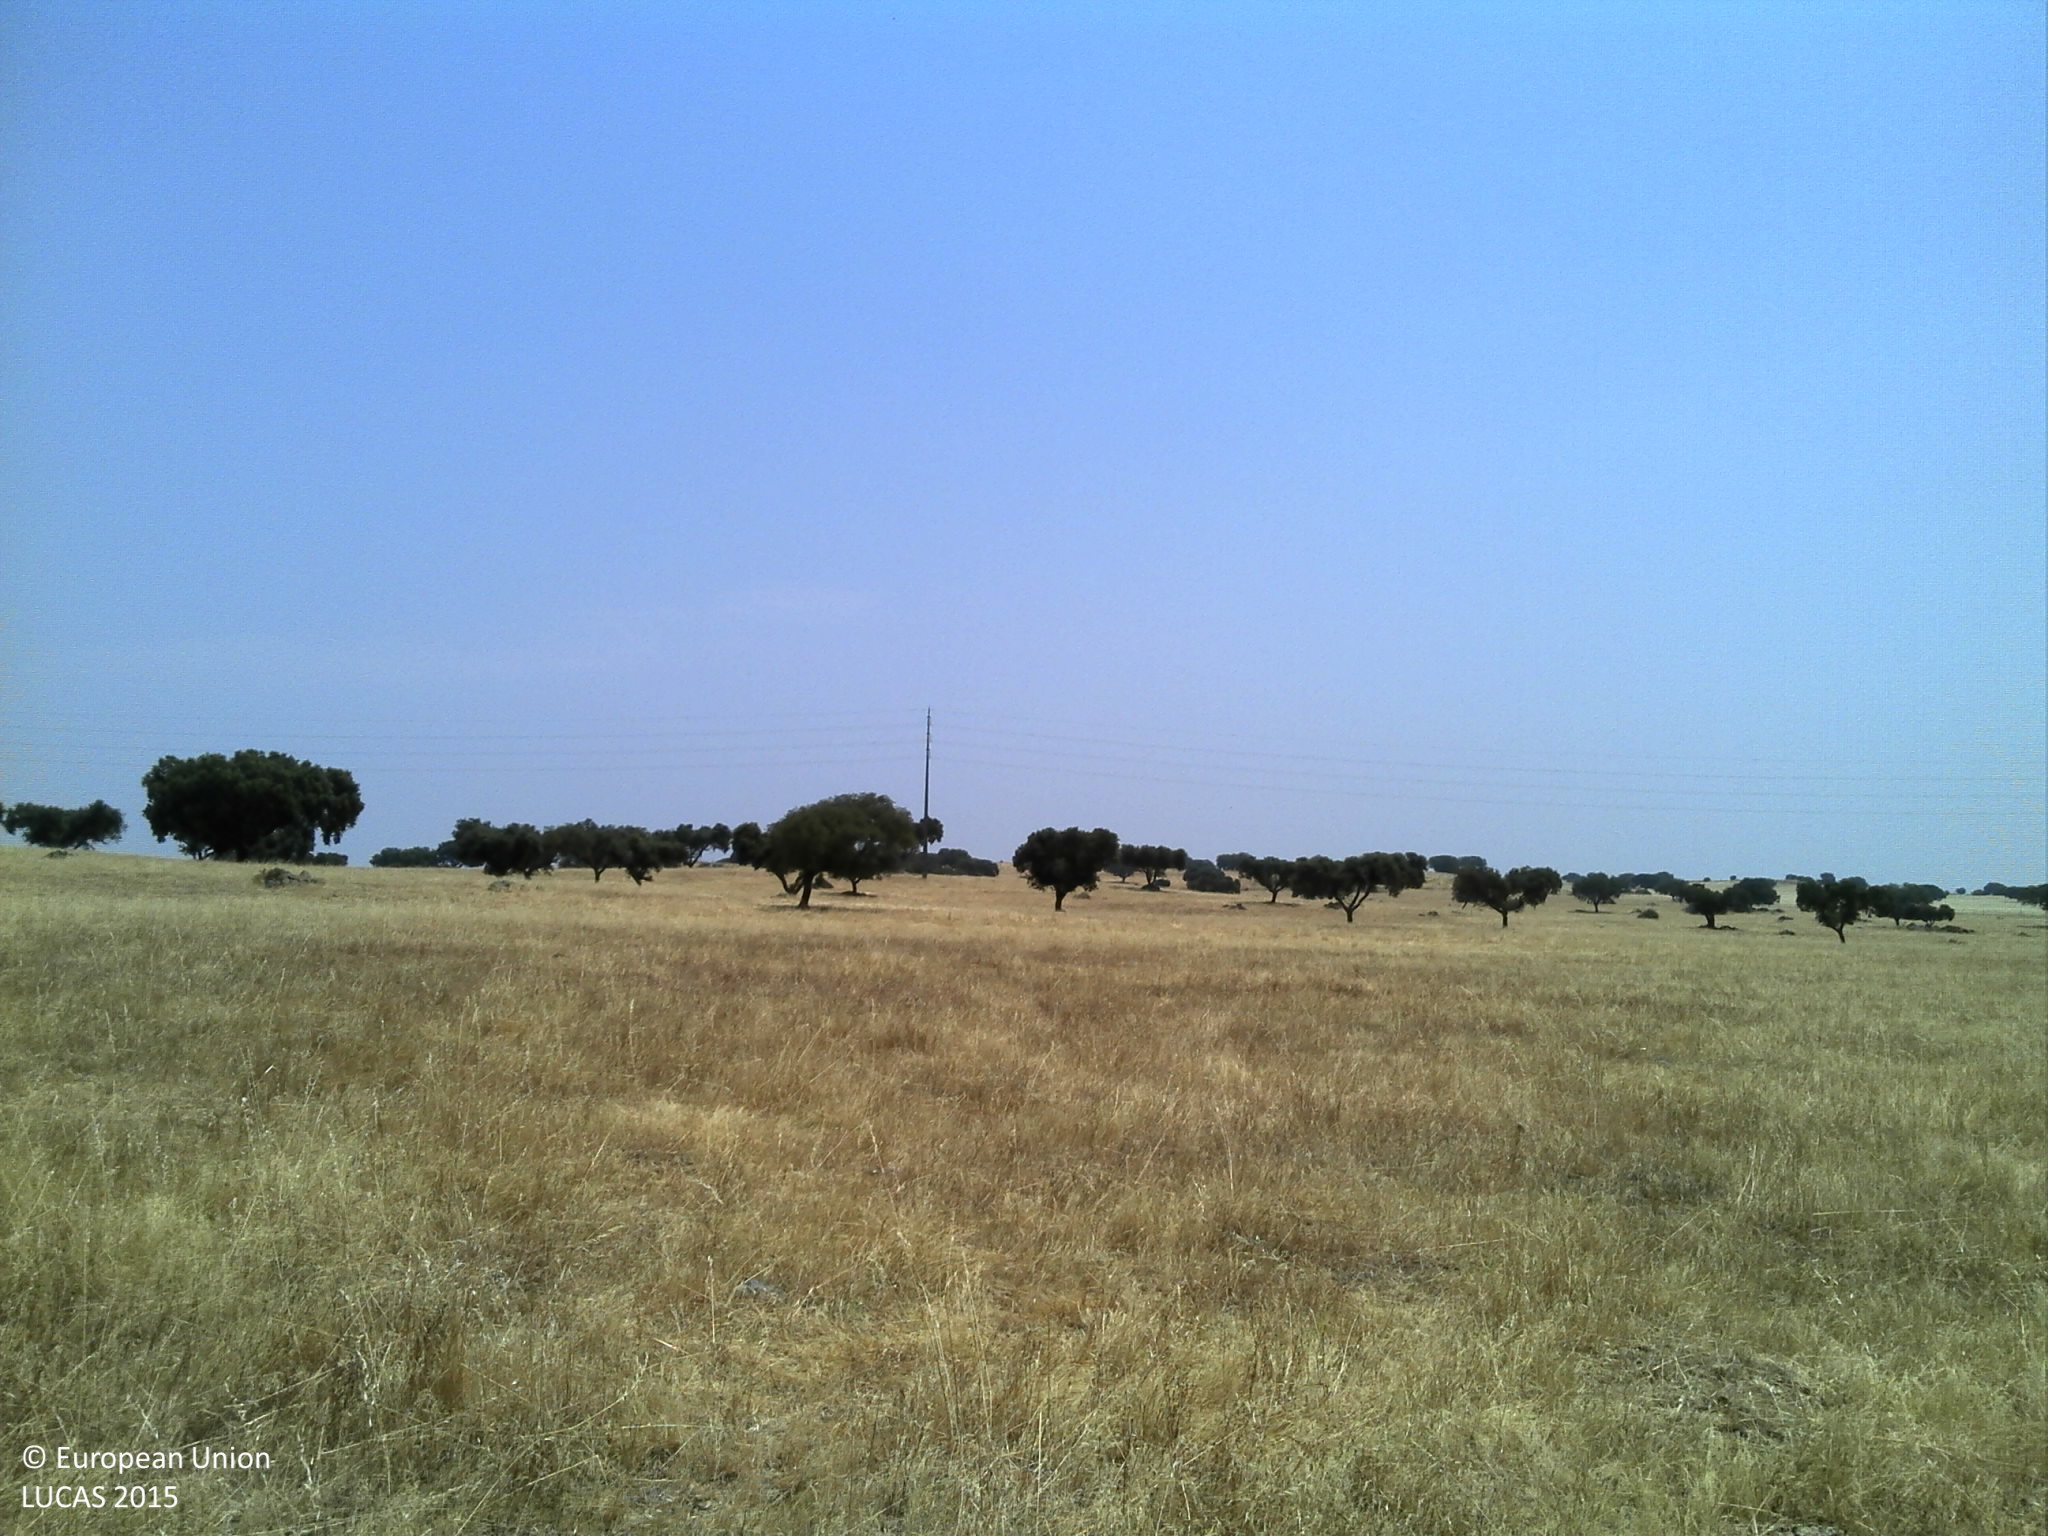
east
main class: Grassland
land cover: Grassland without tree/shrub cover
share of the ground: 50 - 75 %
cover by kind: herbaceous plants 60 %, unconsolidated bare surface 40 %
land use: Agriculture (excluding fallow land and kitchen gardens)
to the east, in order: Grassland without tree/shrub cover; Broadleaved woodland; Grassland without tree/shrub cover
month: June
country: PT
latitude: 38.4744
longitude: -7.8134
